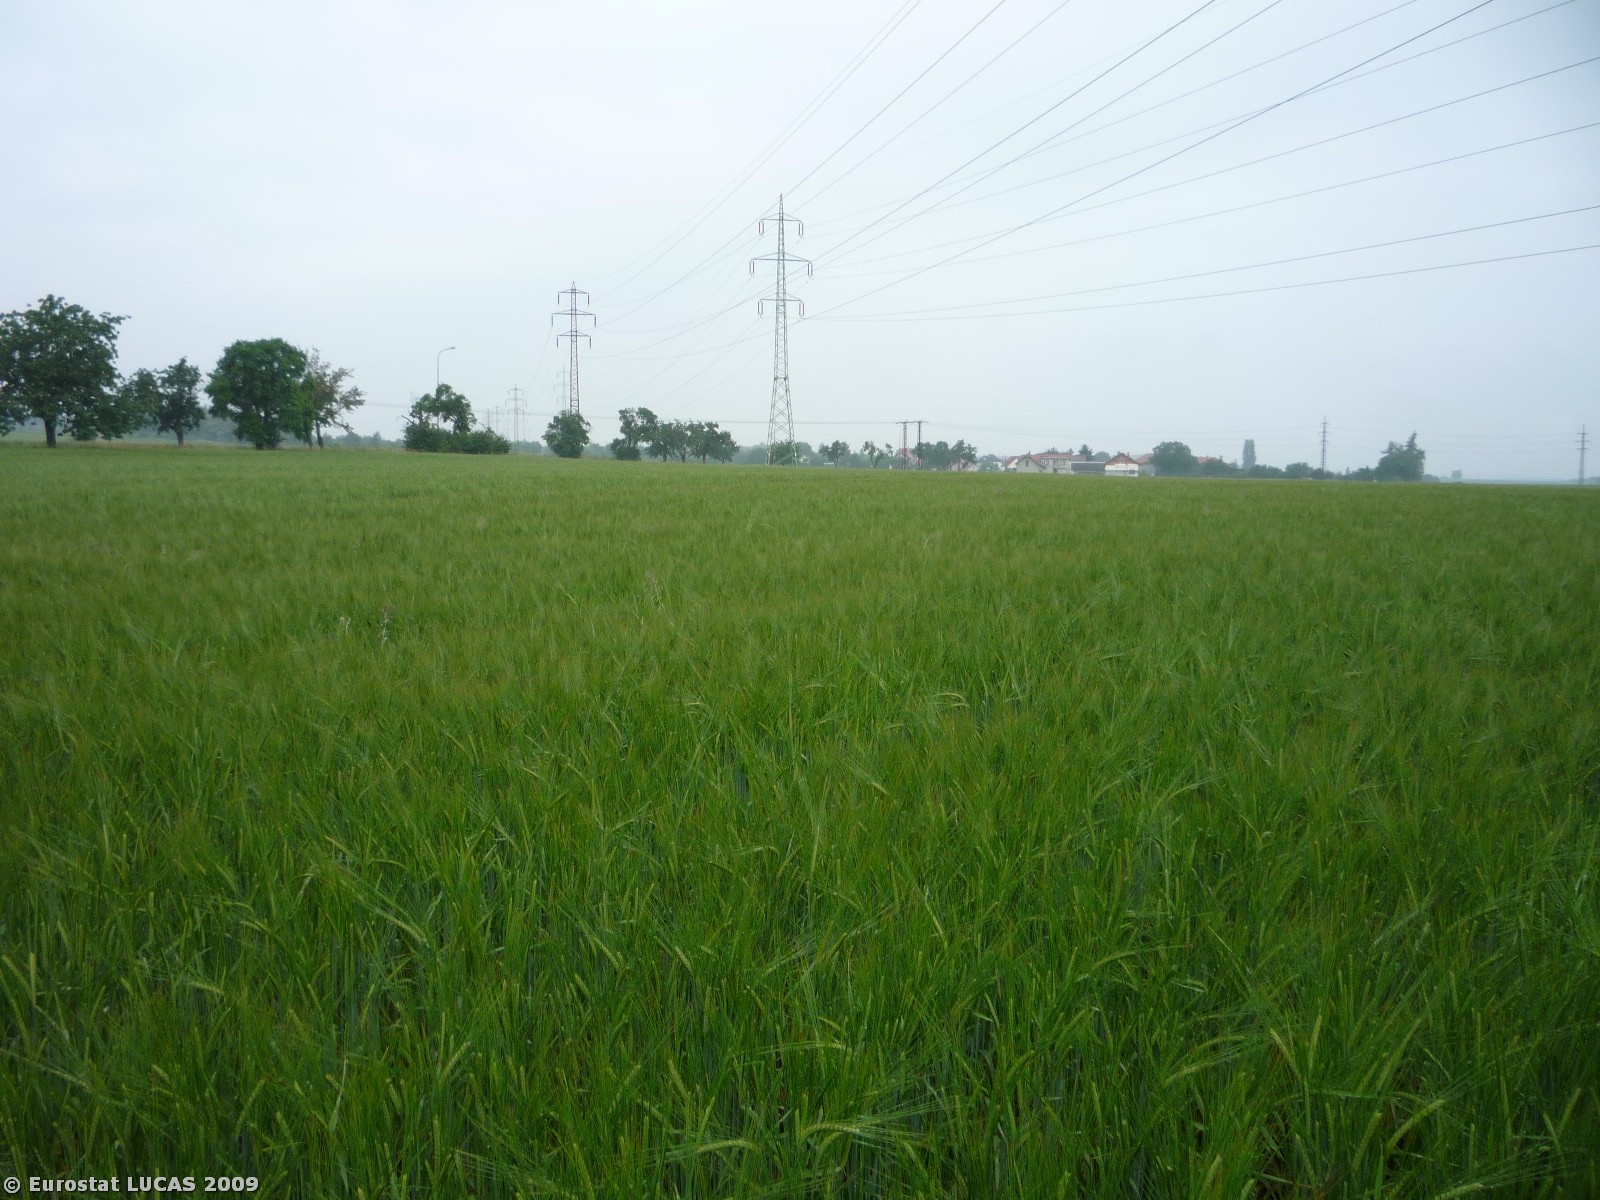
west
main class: Cropland
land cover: Barley
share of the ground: > 75 %
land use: Agriculture (excluding fallow land and kitchen gardens)
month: June
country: CZ
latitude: 50.1145
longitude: 14.9111
